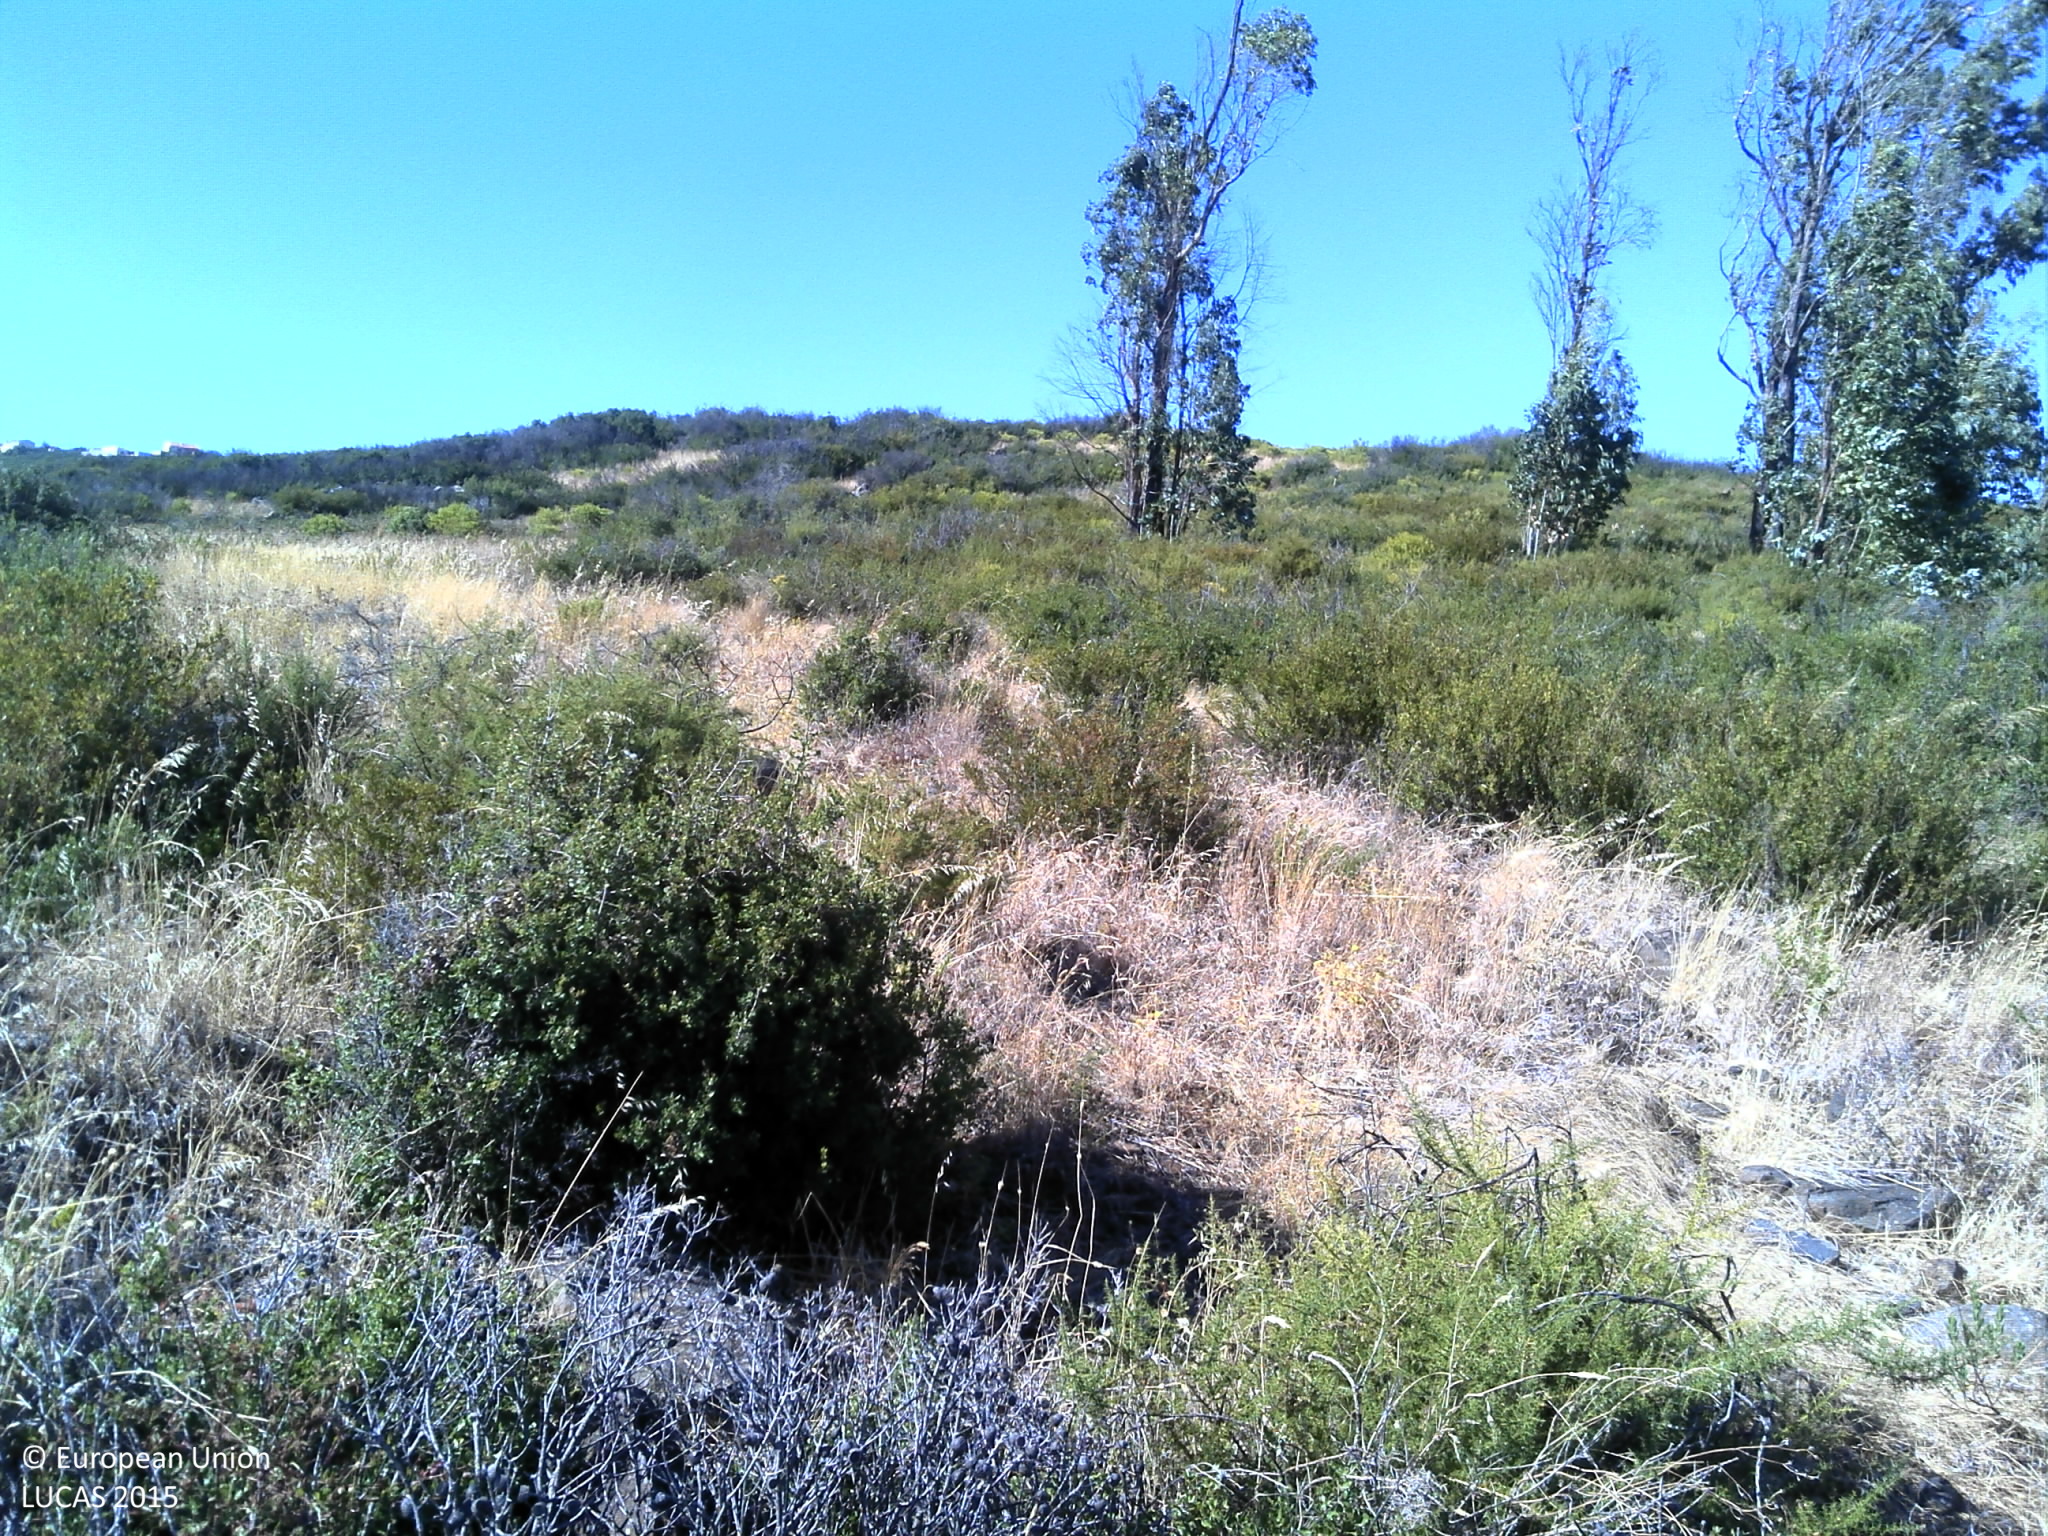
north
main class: Shrubland
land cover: Shrubland with sparse tree cover
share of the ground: 50 - 75 %
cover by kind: shrubs 65 %, unconsolidated bare surface 30 %, broadleaved forest trees 5 %
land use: Semi-natural and natural areas not in use
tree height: > 5 m
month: August
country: PT
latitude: 38.8566
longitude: -9.1733
